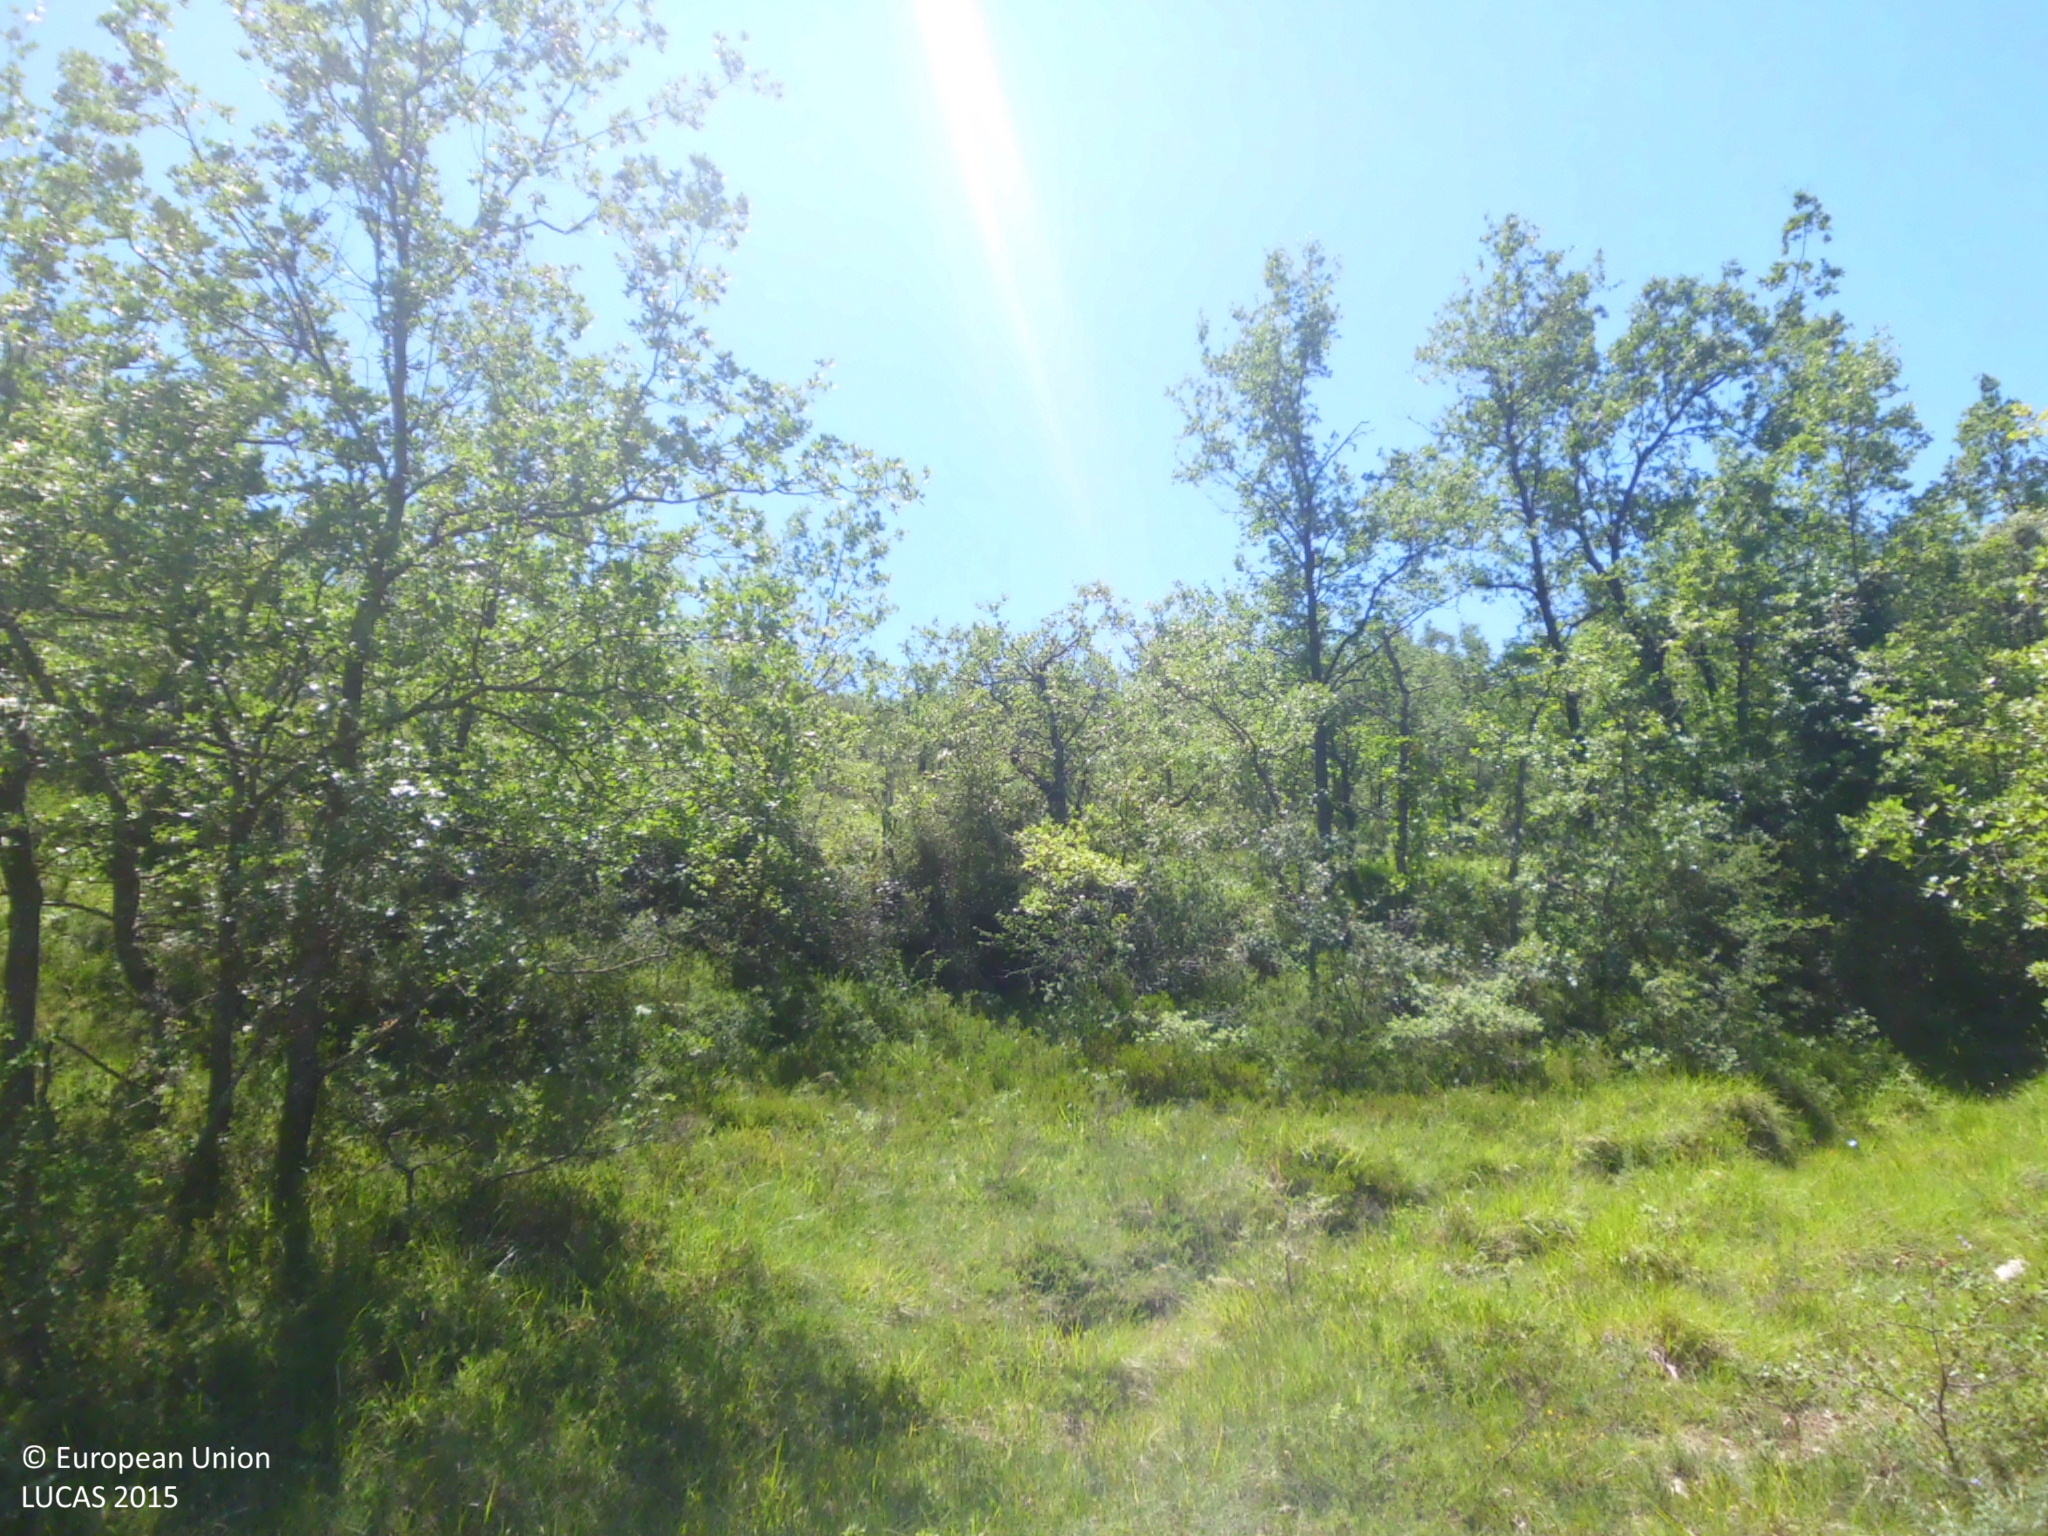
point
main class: Grassland
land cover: Grassland with sparse tree/shrub cover
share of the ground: > 75 %
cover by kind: herbaceous plants 90 %, broadleaved forest trees 5 %, shrubs 5 %
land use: Agriculture (excluding fallow land and kitchen gardens)
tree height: < 5 m
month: June
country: ES
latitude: 42.8799
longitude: -3.4936
